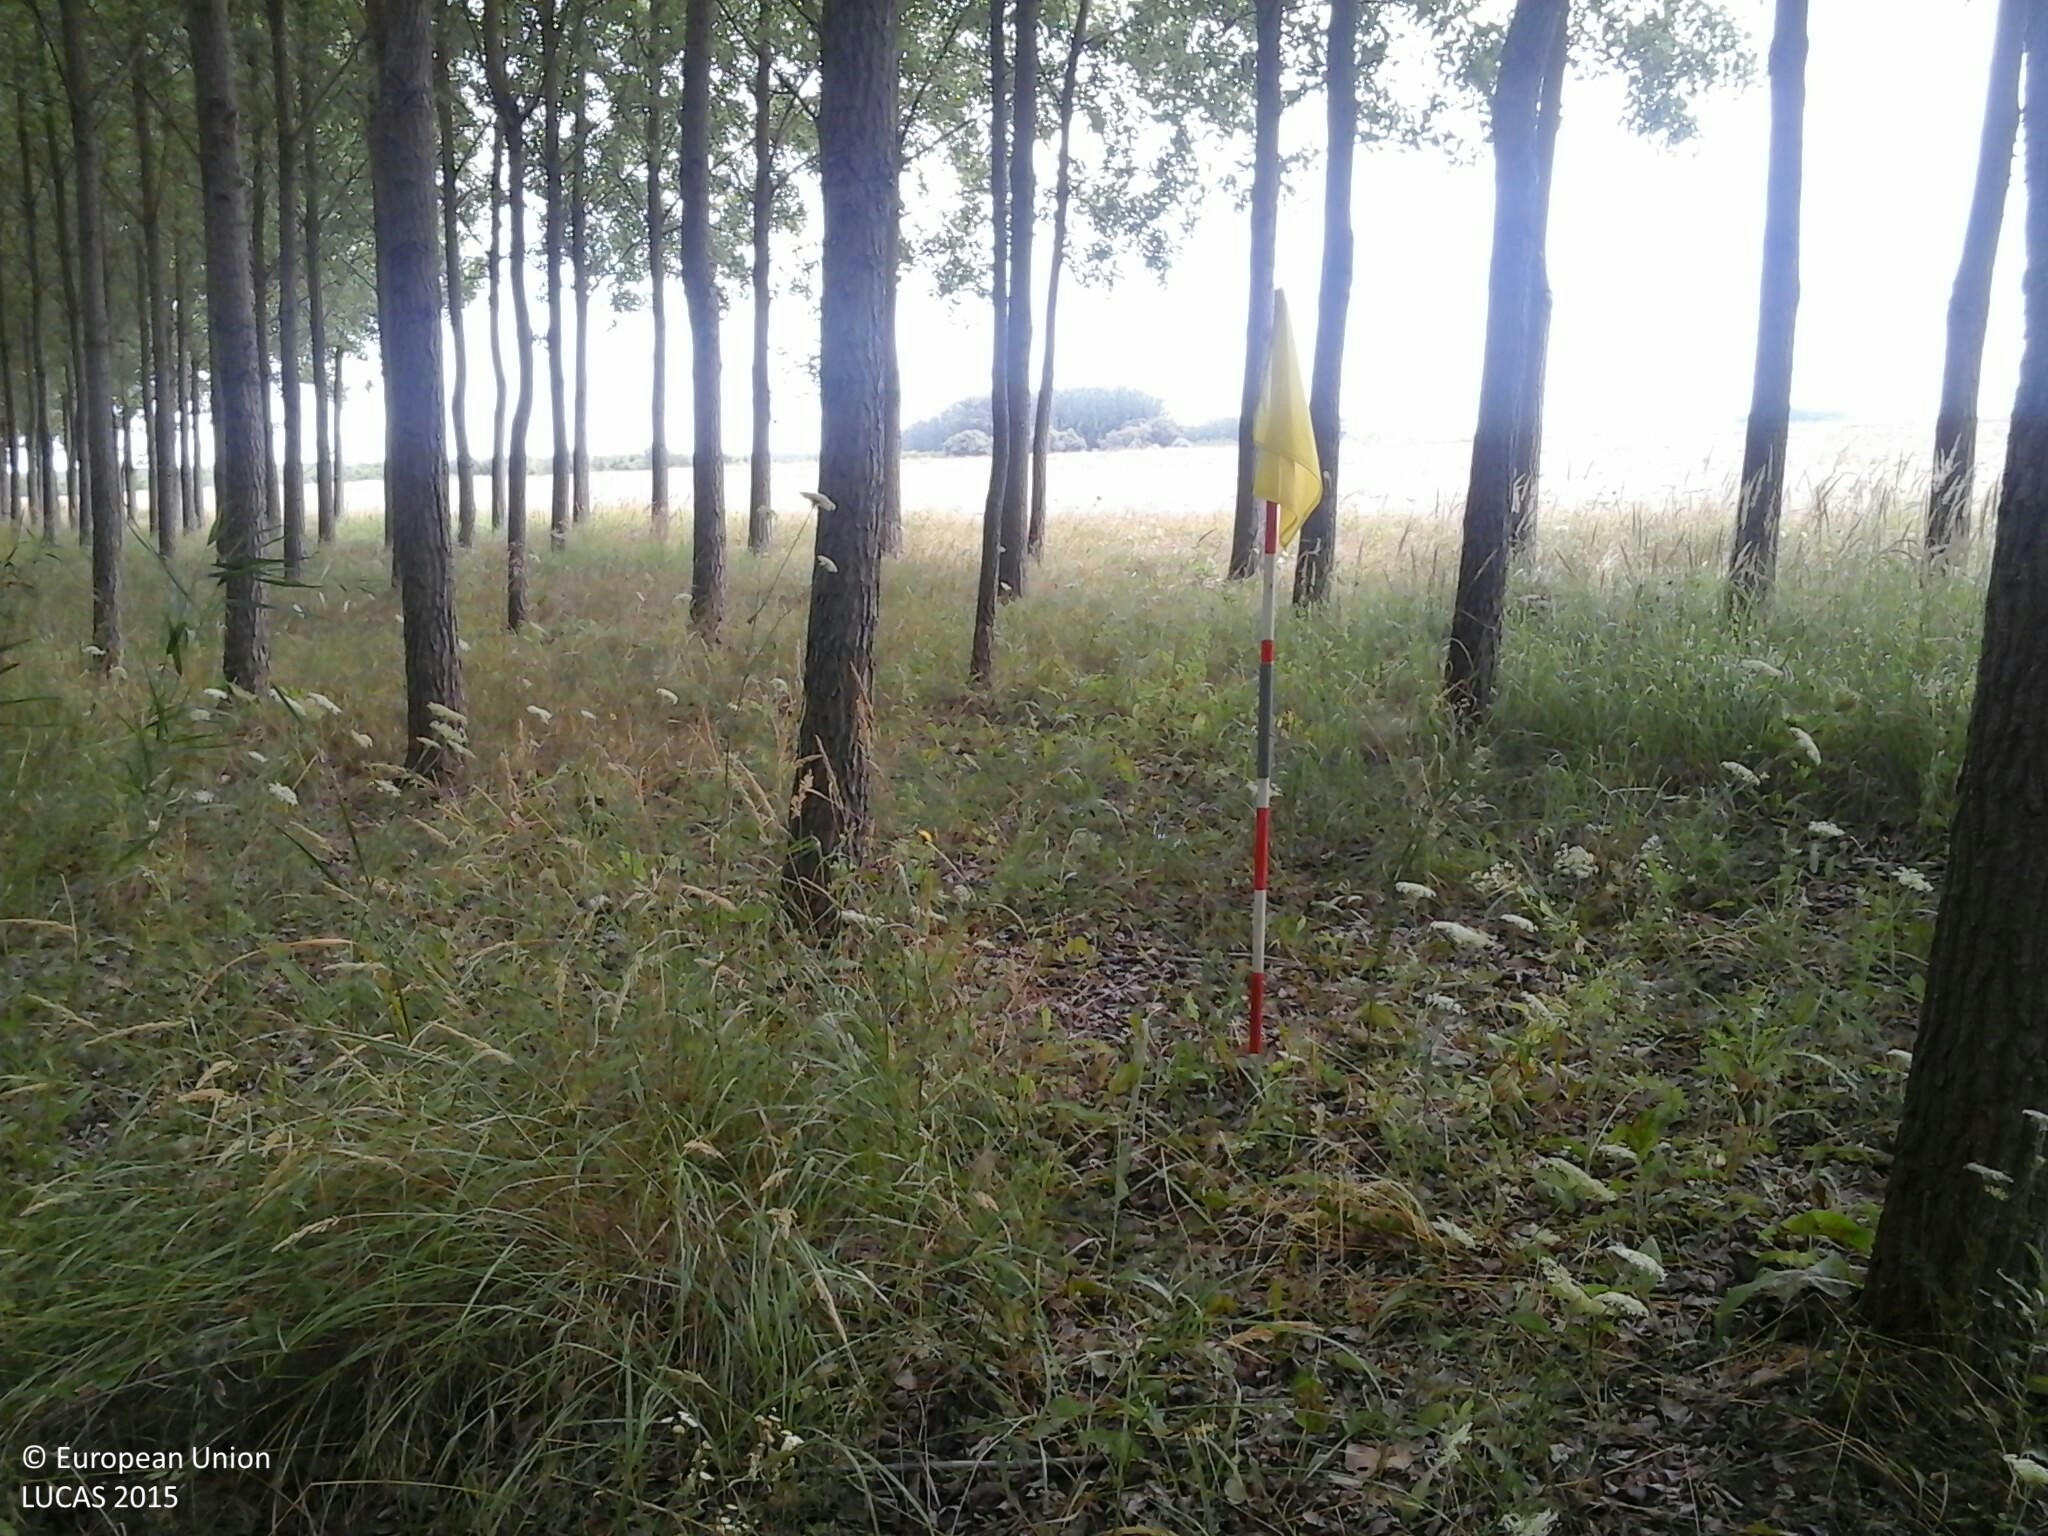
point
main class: Woodland
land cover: Broadleaved woodland
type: non-riverine alder, birch or aspen forest
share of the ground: 50 - 75 %
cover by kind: broadleaved forest trees 80 %, herbaceous plants 20 %
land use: Forestry
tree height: > 5 m
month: July
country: HU
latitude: 47.7203
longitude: 20.8742
